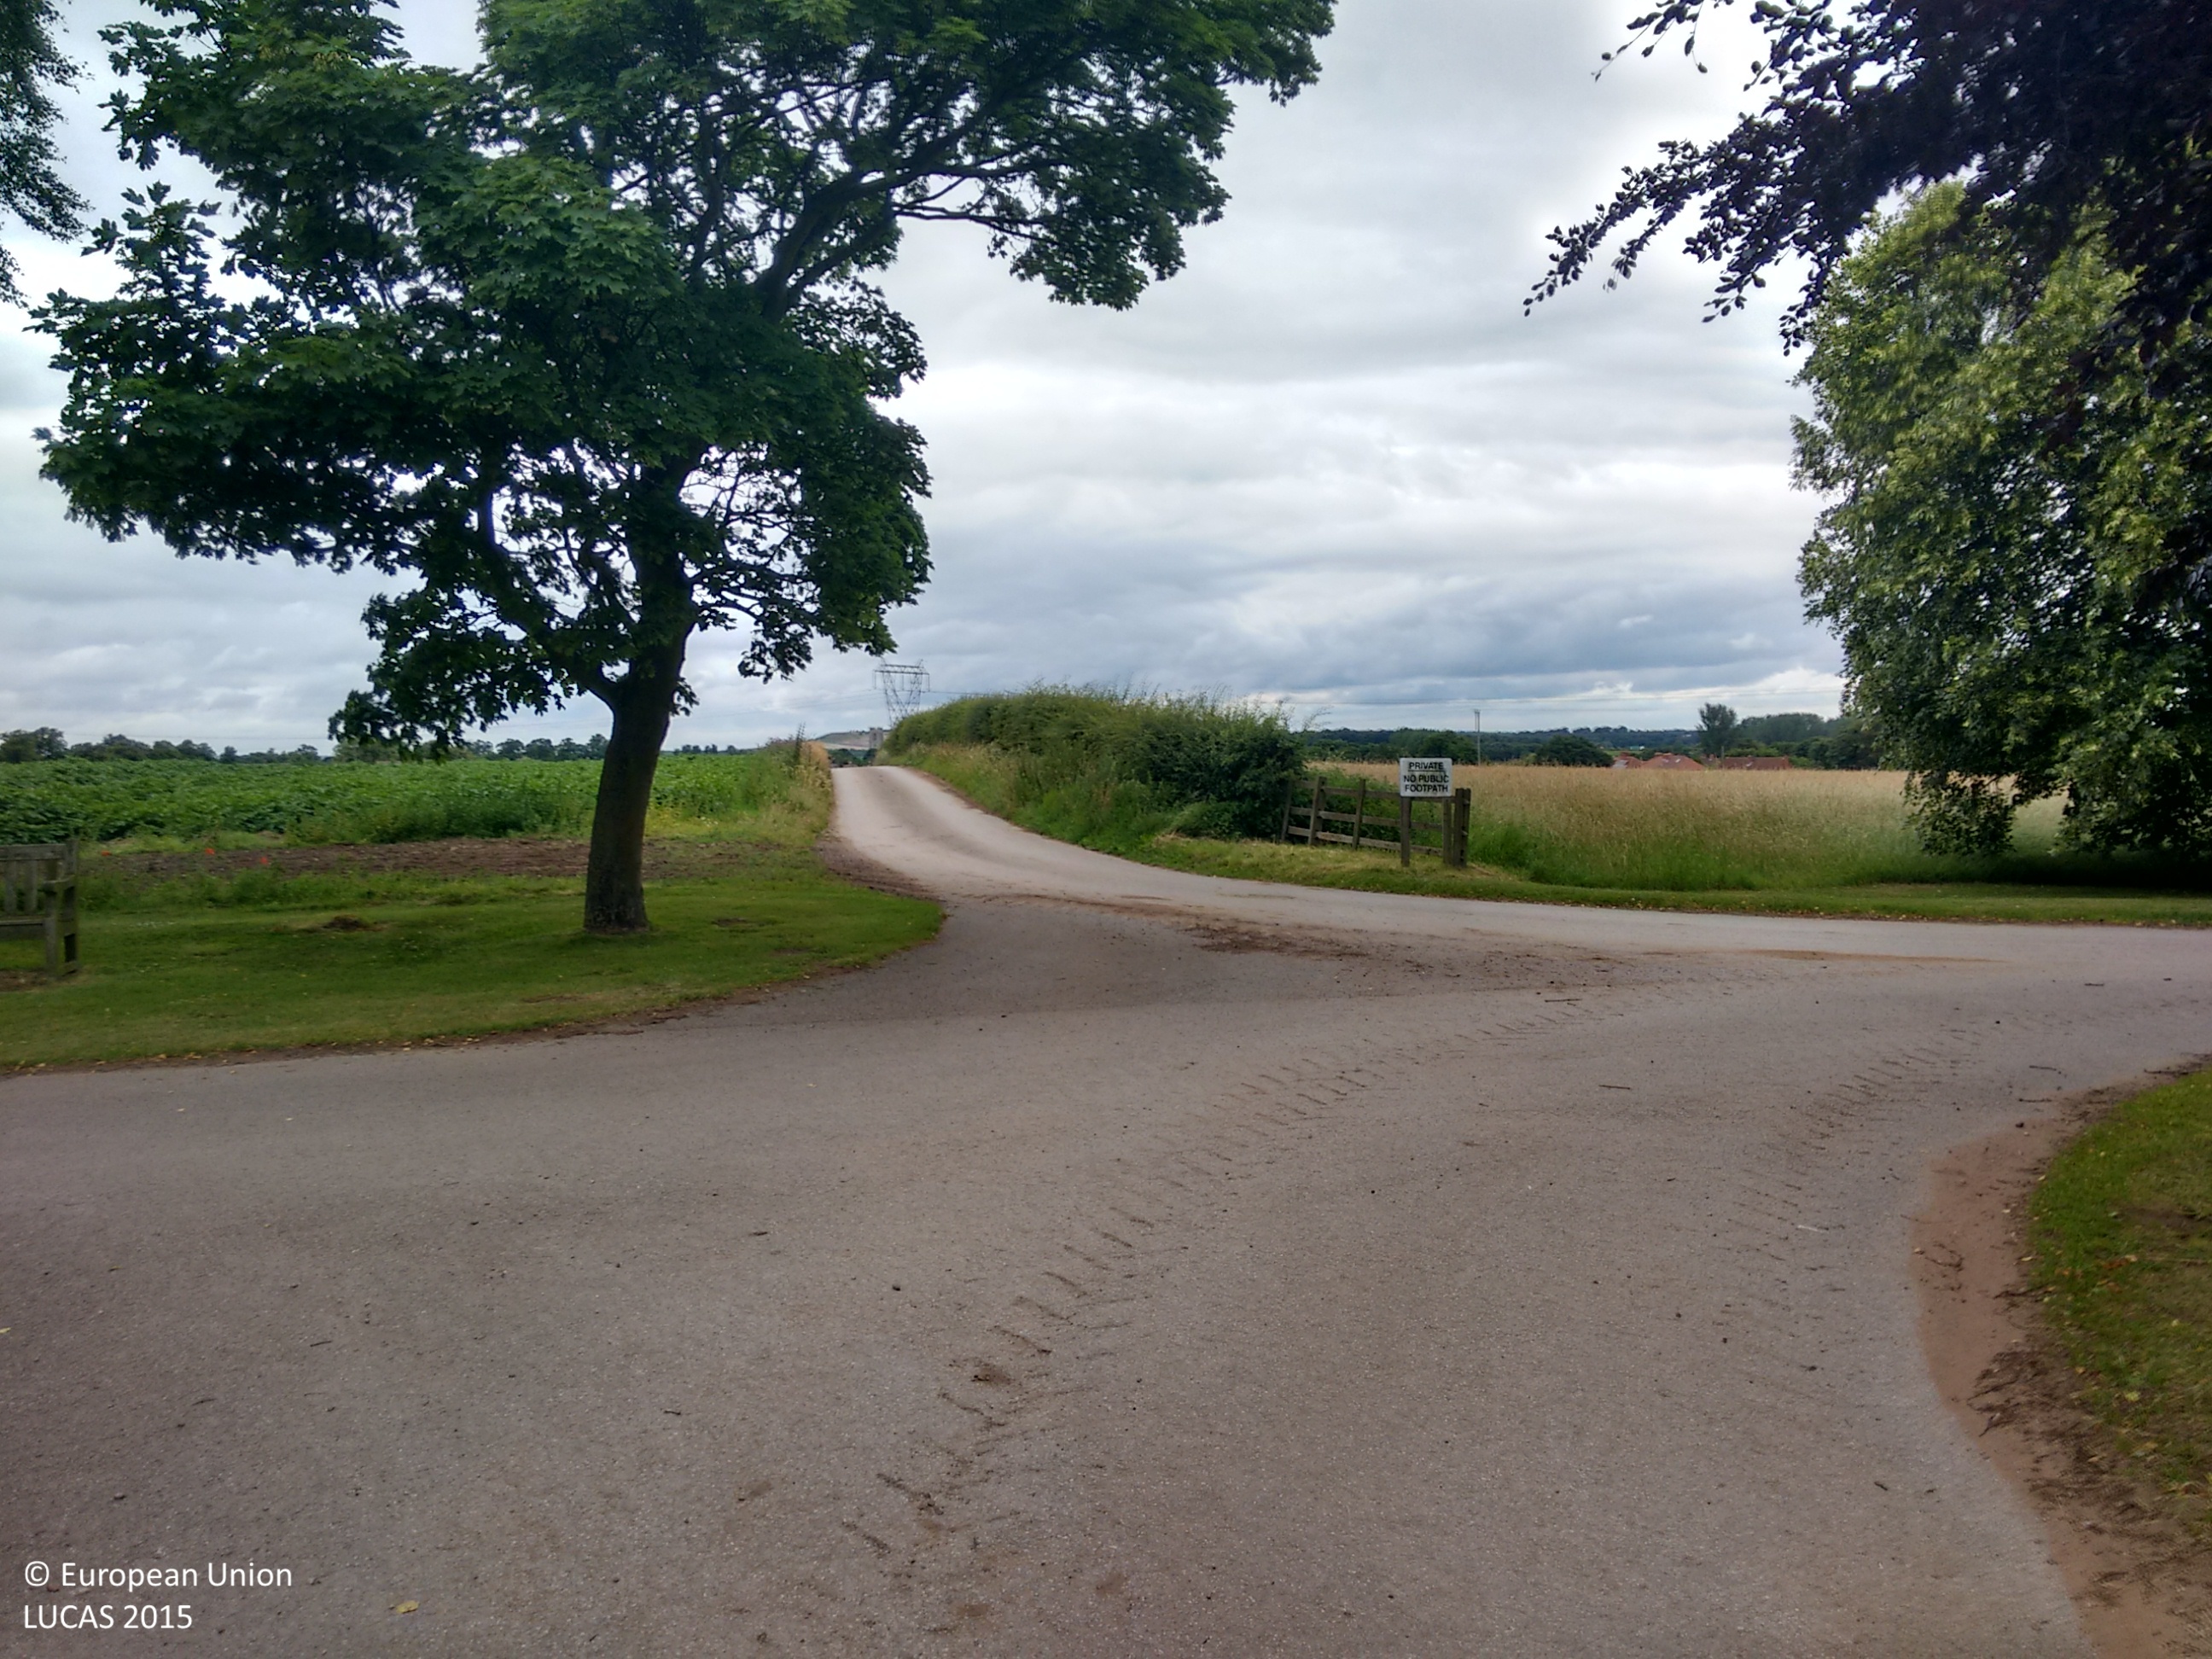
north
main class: Cropland
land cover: Potatoes
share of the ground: > 75 %
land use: Agriculture (excluding fallow land and kitchen gardens)
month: July
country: GB
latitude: 53.3656
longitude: -1.0598
